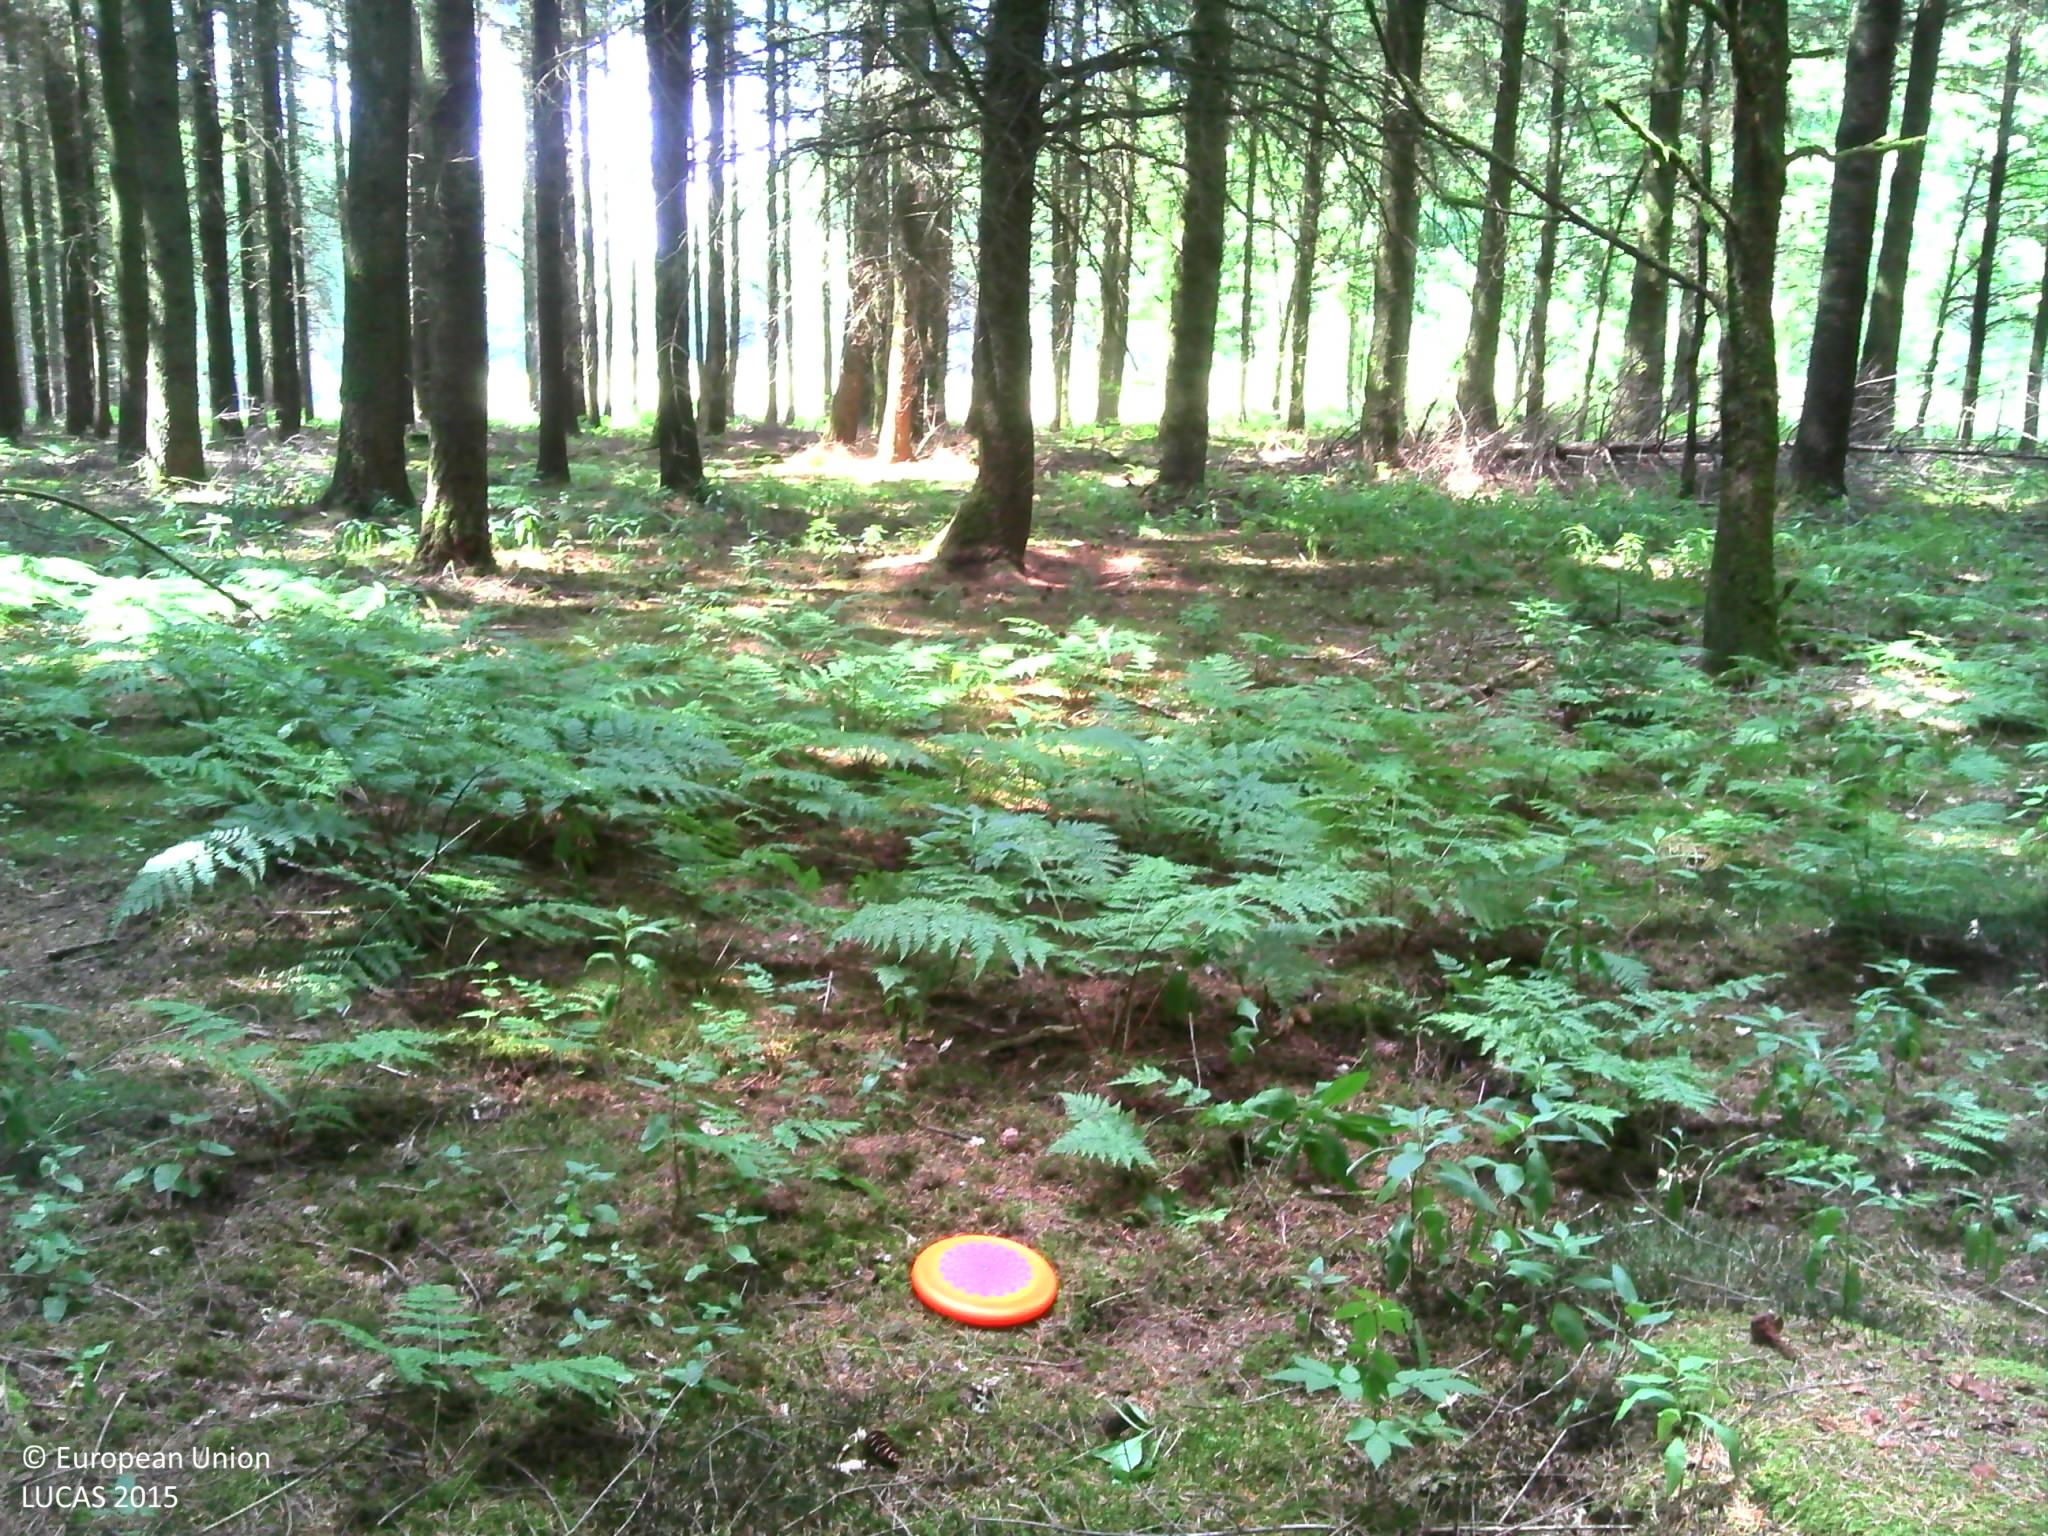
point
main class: Woodland
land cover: Other coniferous woodland
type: exotic forest
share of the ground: > 75 %
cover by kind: coniferous forest trees 95 %, herbaceous plants 5 %
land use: Forestry
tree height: > 5 m
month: July
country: BE
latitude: 49.8880
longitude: 5.7257
